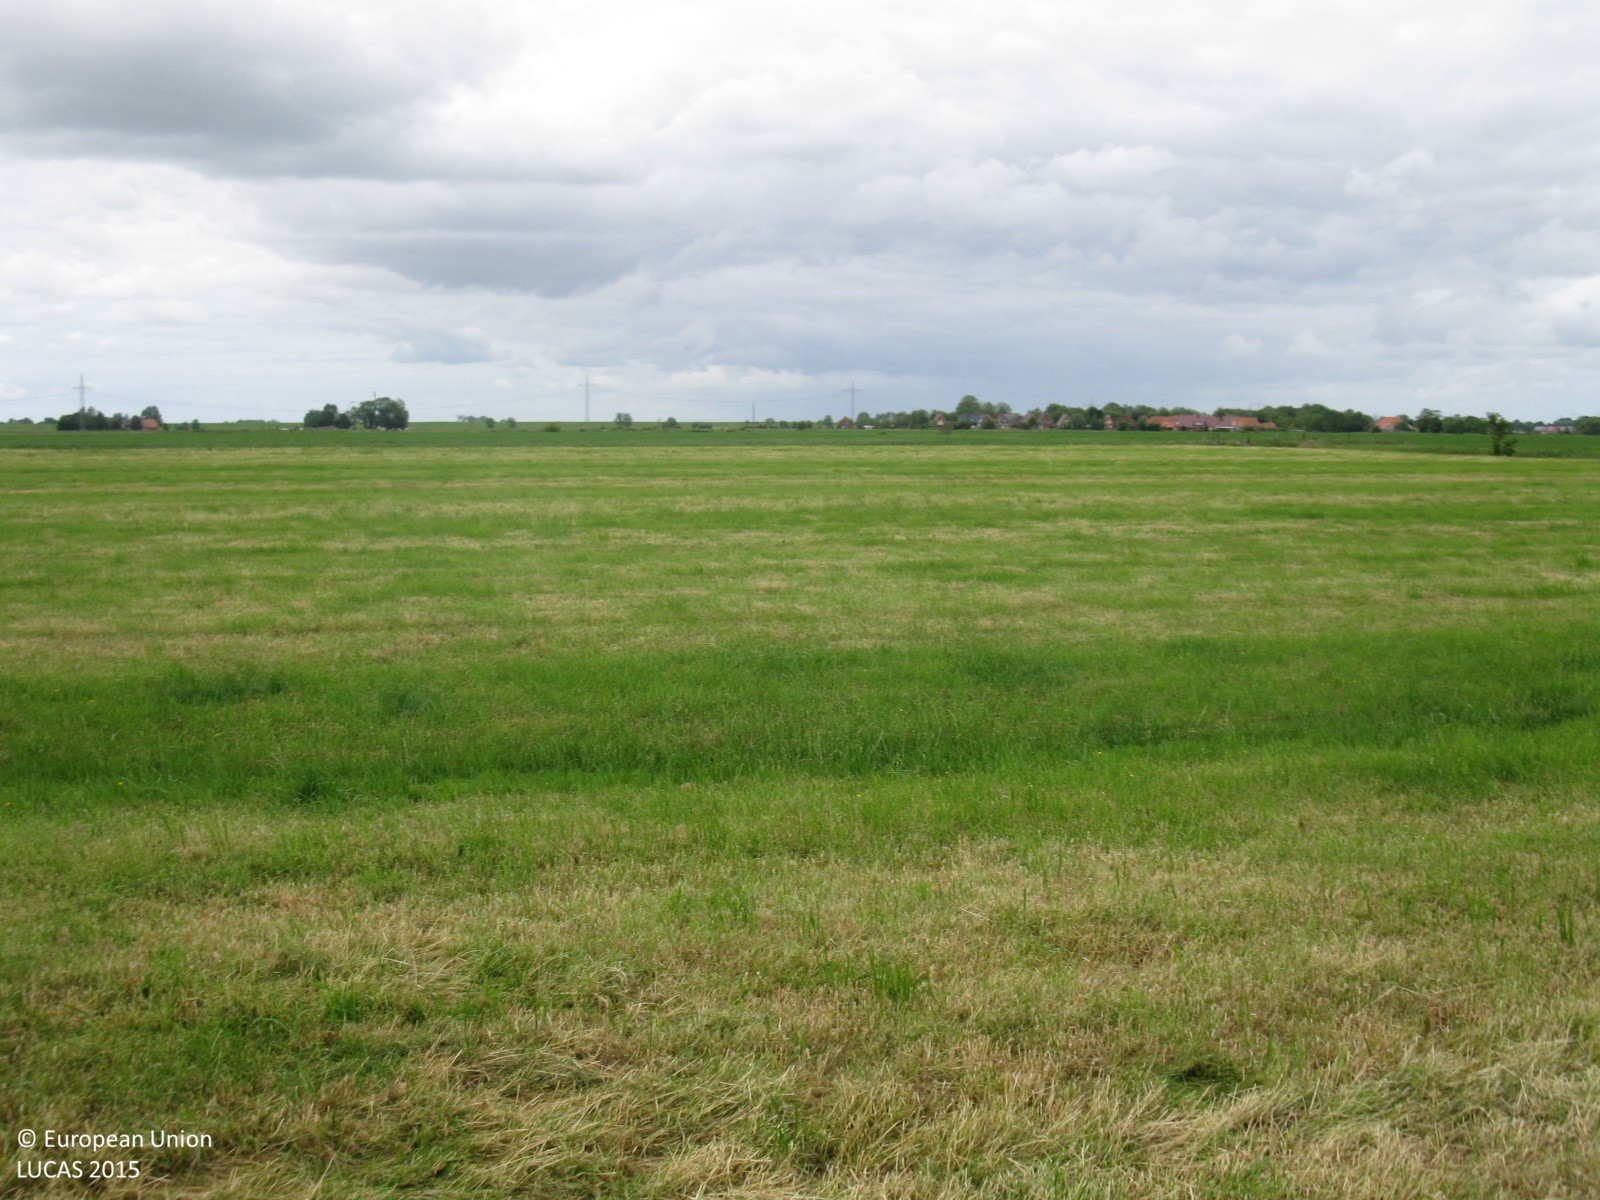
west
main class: Grassland
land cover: Grassland without tree/shrub cover
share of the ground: > 75 %
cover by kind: herbaceous plants 100 %
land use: Agriculture (excluding fallow land and kitchen gardens)
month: June
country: DE
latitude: 53.3195
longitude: 7.3735
